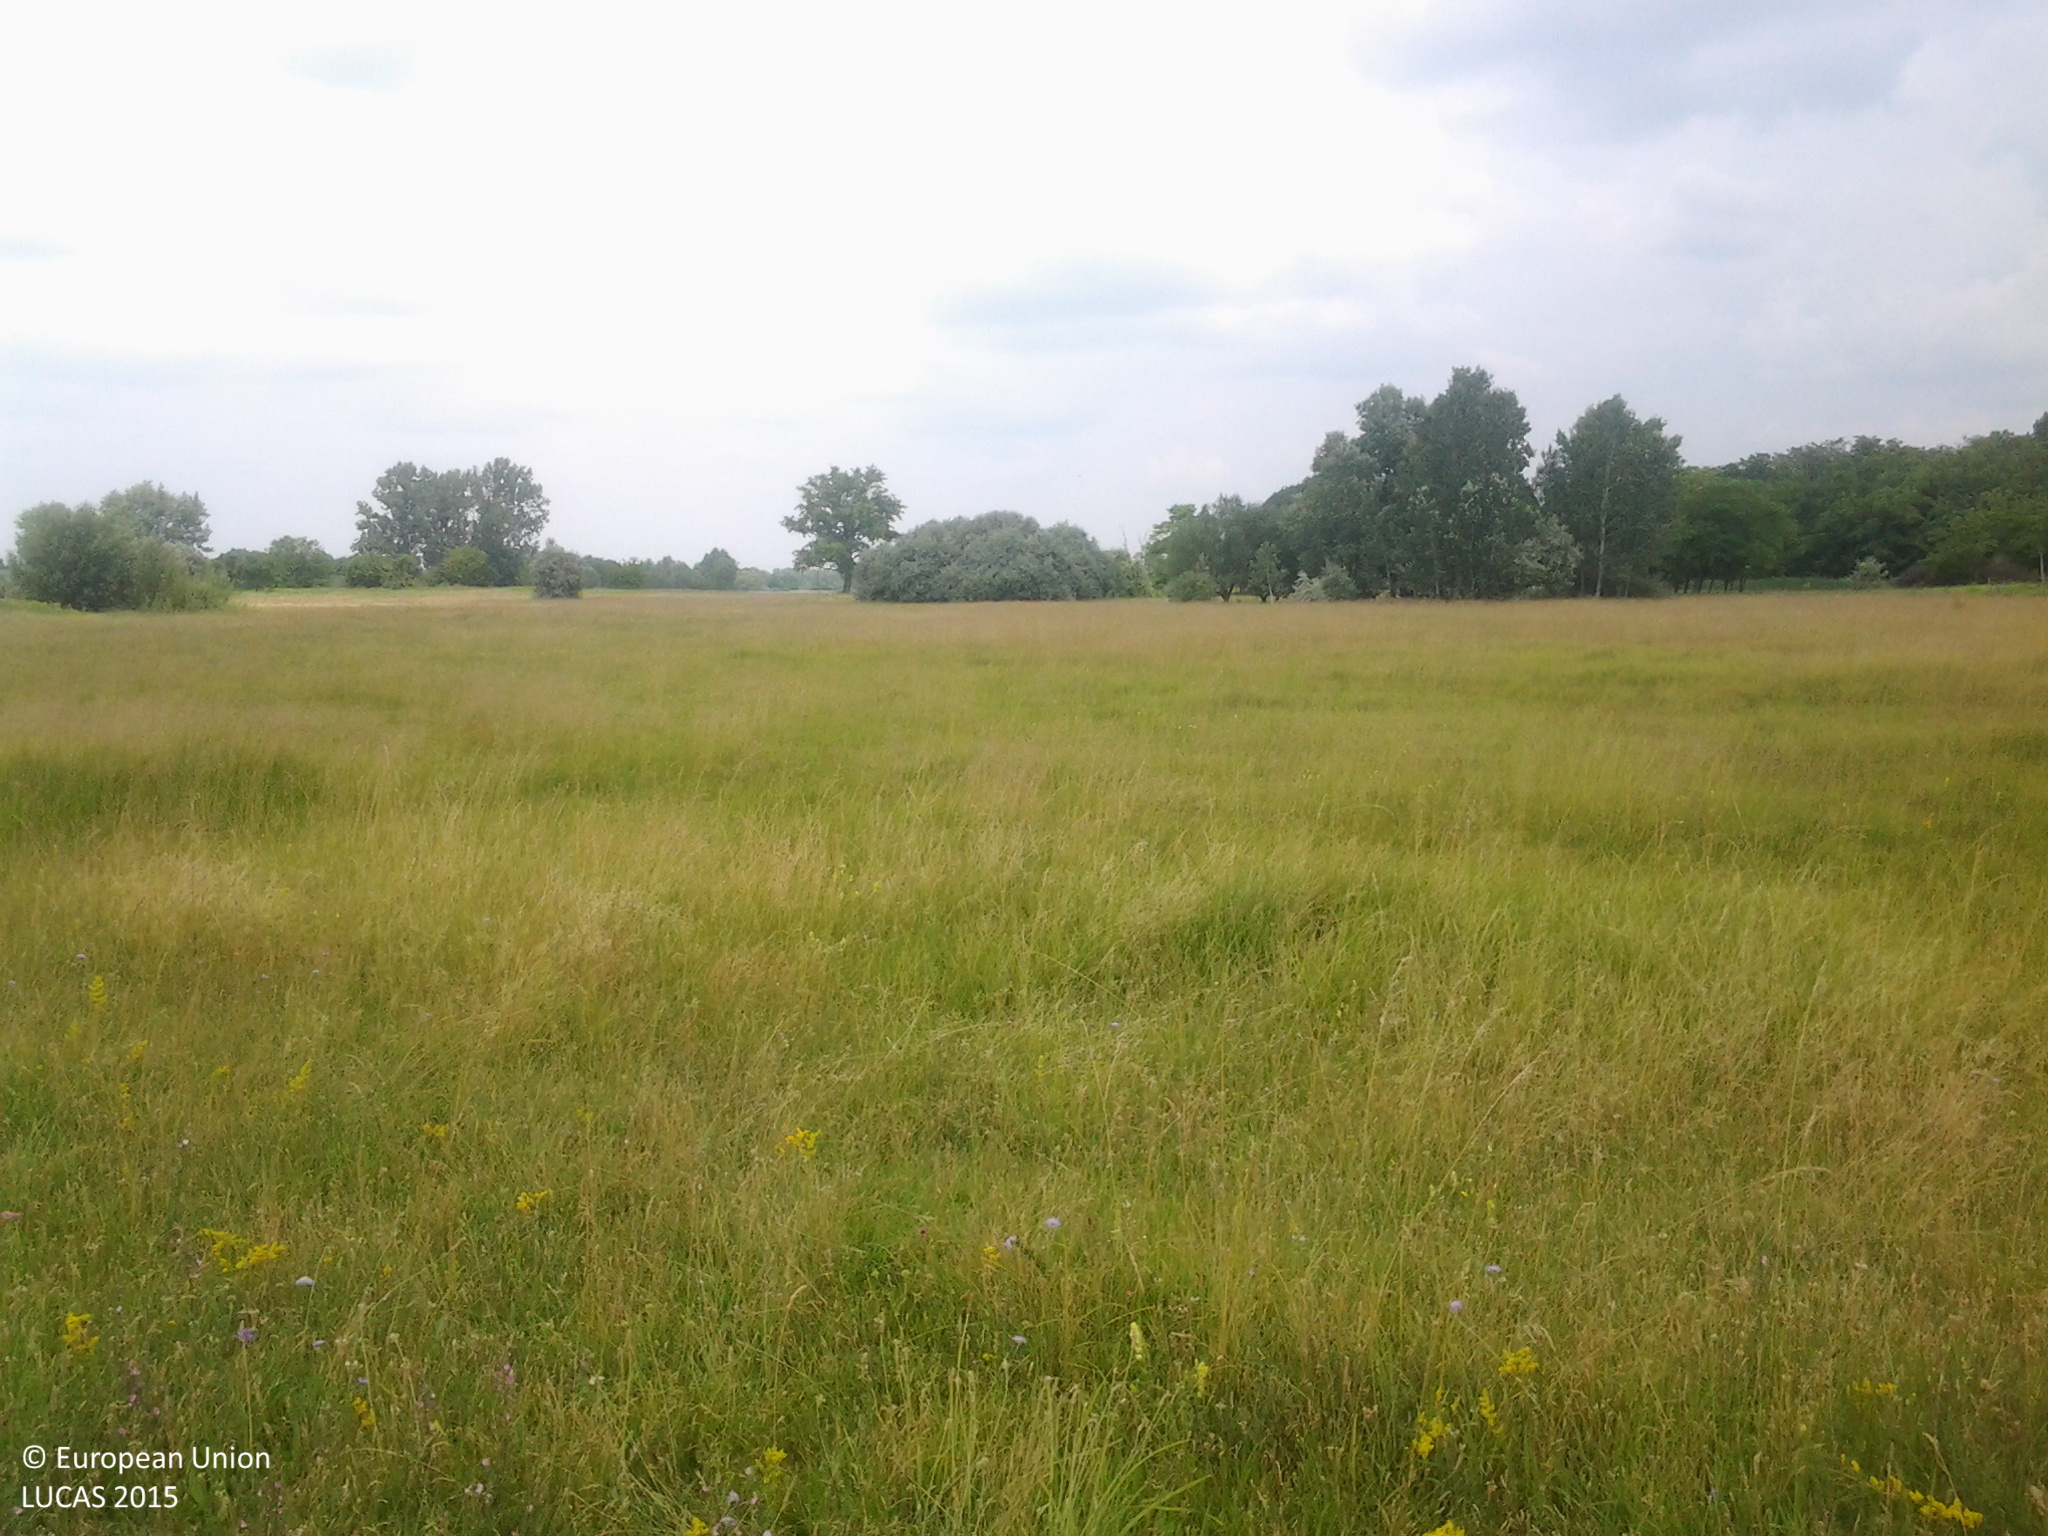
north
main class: Grassland
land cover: Spontaneously vegetated surfaces
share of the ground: > 75 %
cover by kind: herbaceous plants 100 %
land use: Semi-natural and natural areas not in use
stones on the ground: < 10 %
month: June
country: HU
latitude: 46.7988
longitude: 19.2801
